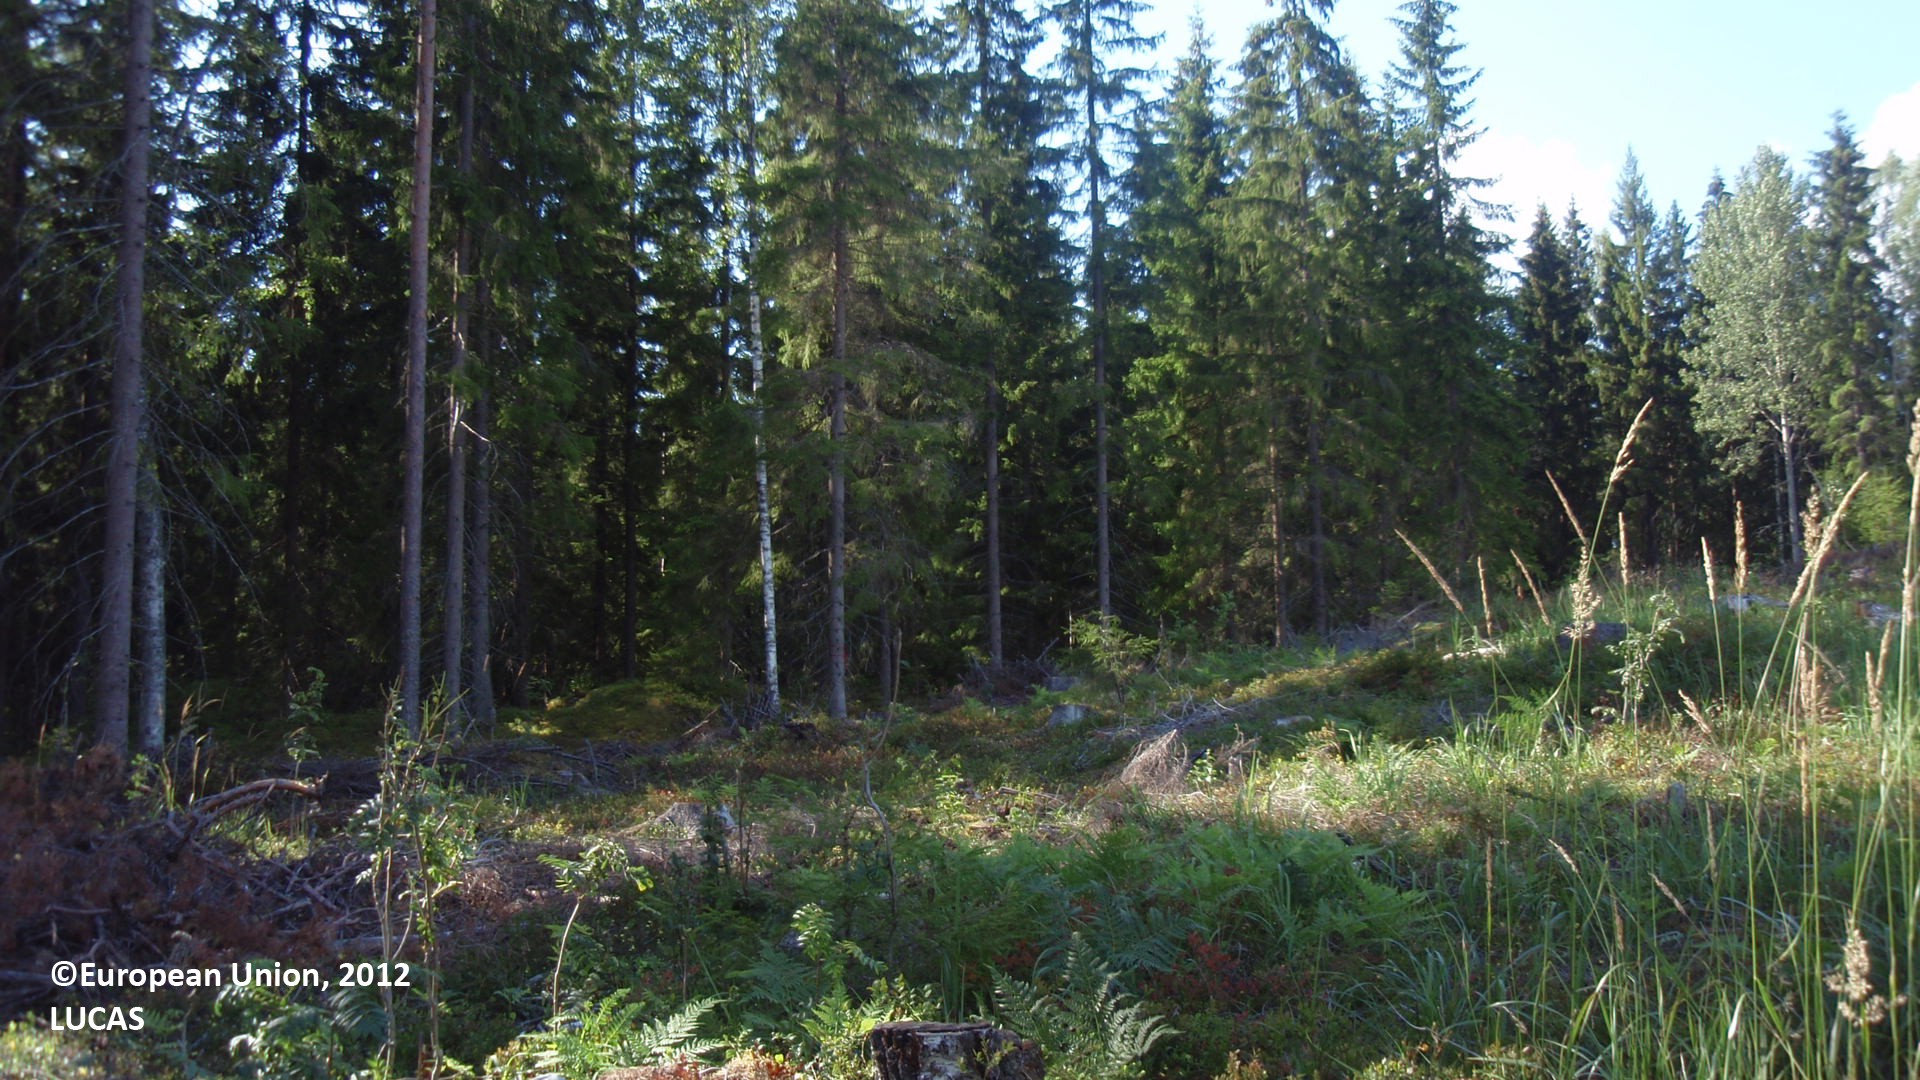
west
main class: Grassland
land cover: Grassland with sparse tree/shrub cover
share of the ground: 25 - 50 %
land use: Forestry
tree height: < 5 m
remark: Clear cut
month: July
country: FI
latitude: 61.1641
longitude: 28.2540
